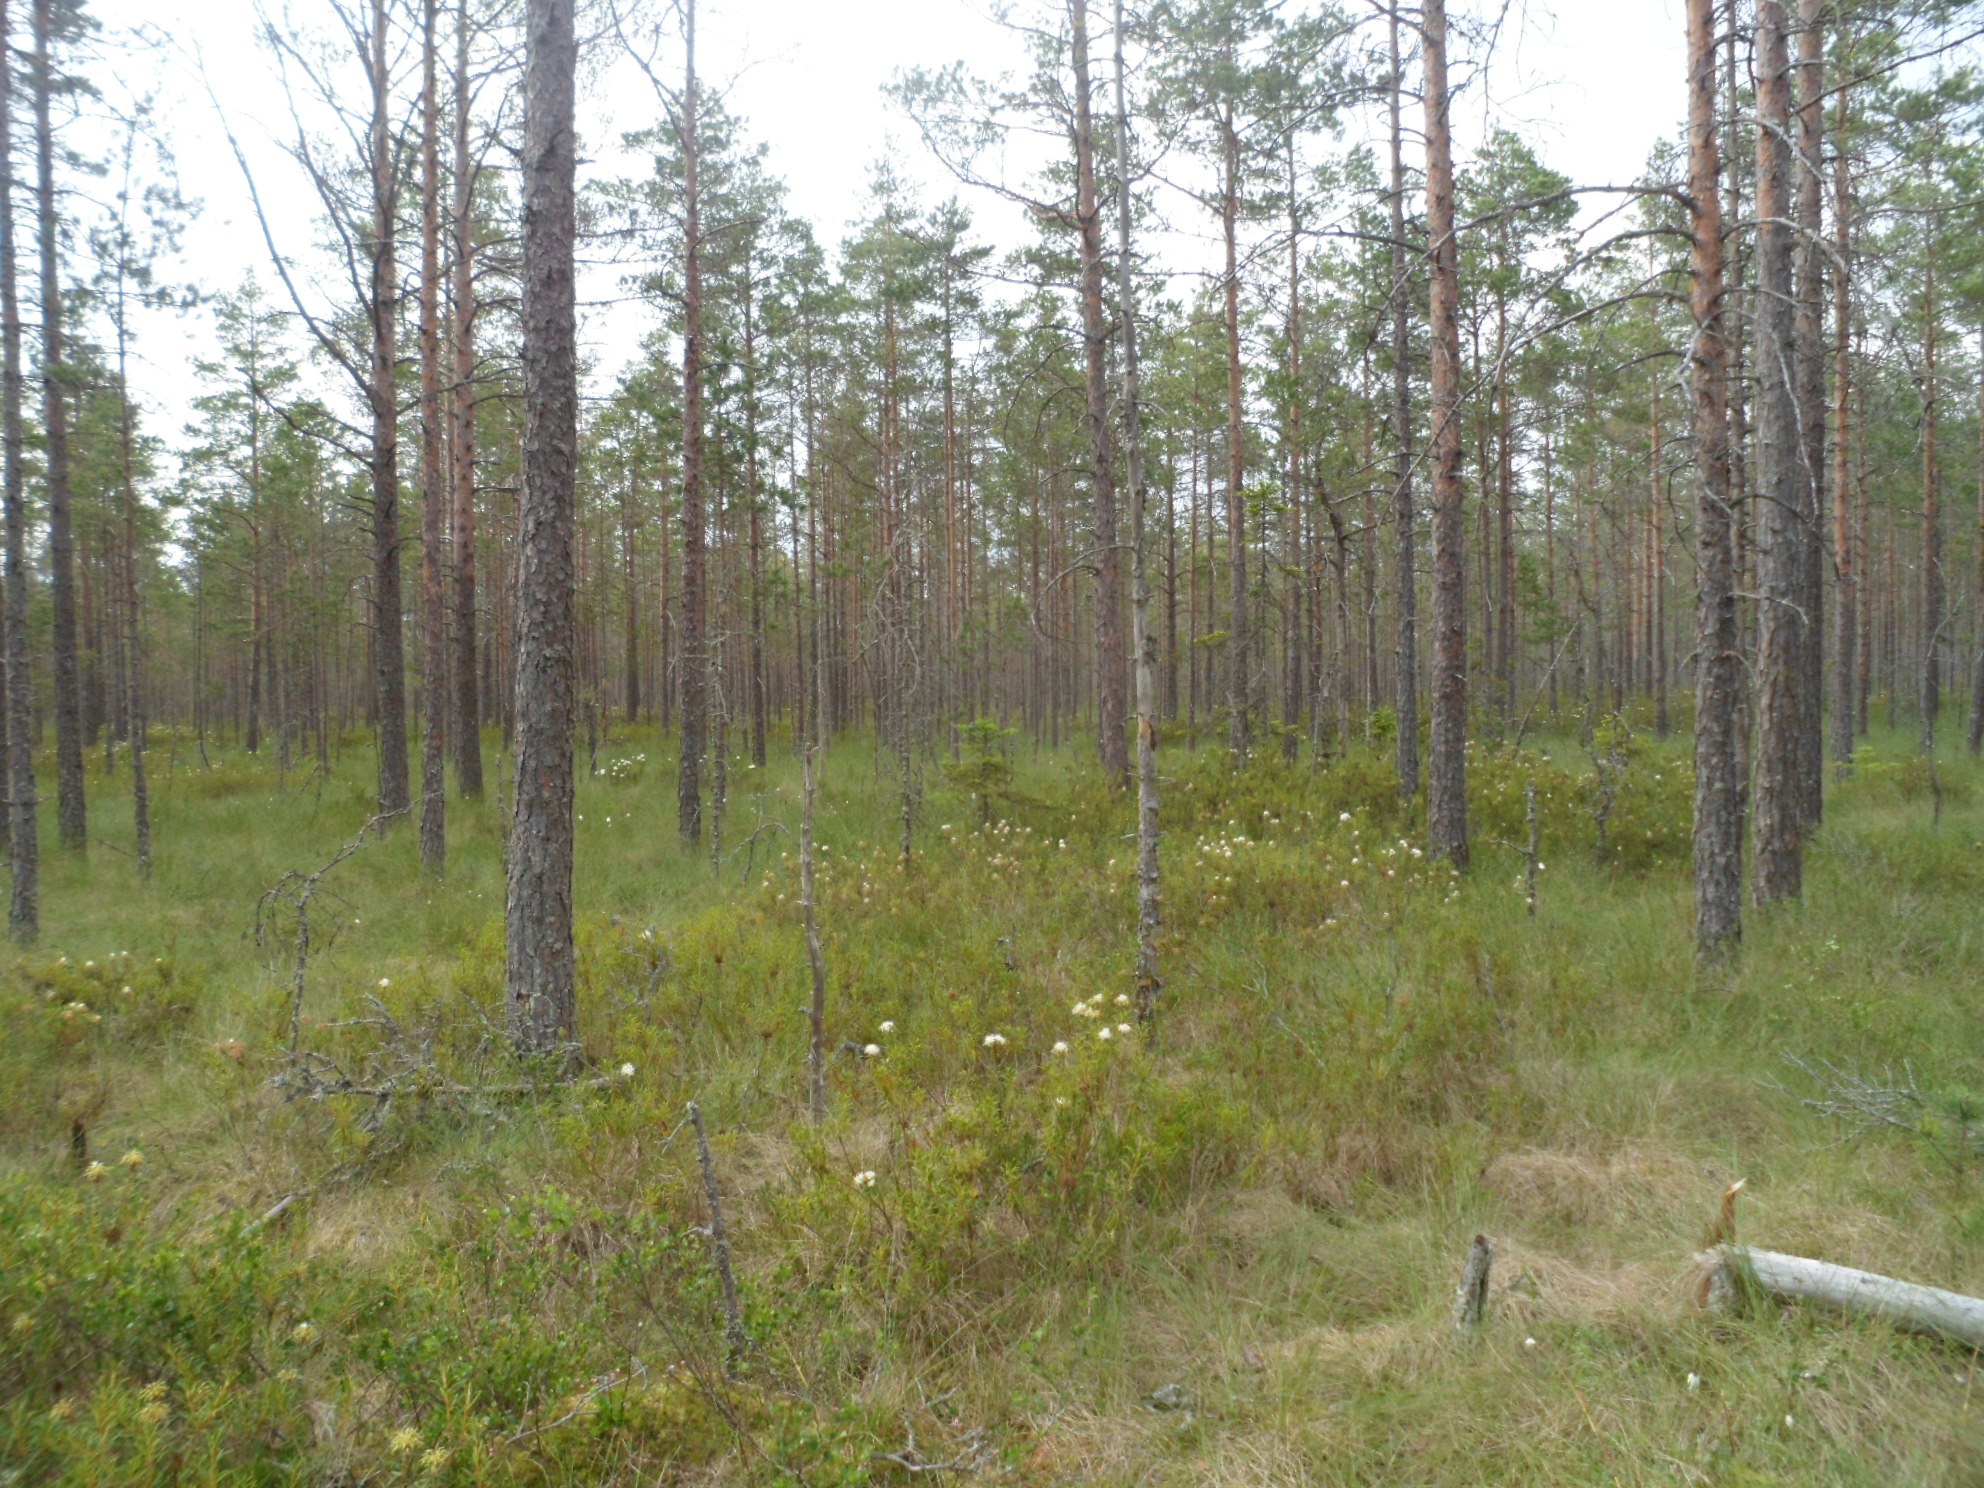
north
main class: Woodland
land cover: Pine dominated coniferous woodland
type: boreal forest
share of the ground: 25 - 50 %
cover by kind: coniferous forest trees 50 %, lichens and mosses 25 %, shrubs 20 %, herbaceous plants 5 %
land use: Forestry
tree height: > 5 m
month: June
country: SE
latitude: 57.1334
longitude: 15.4994
